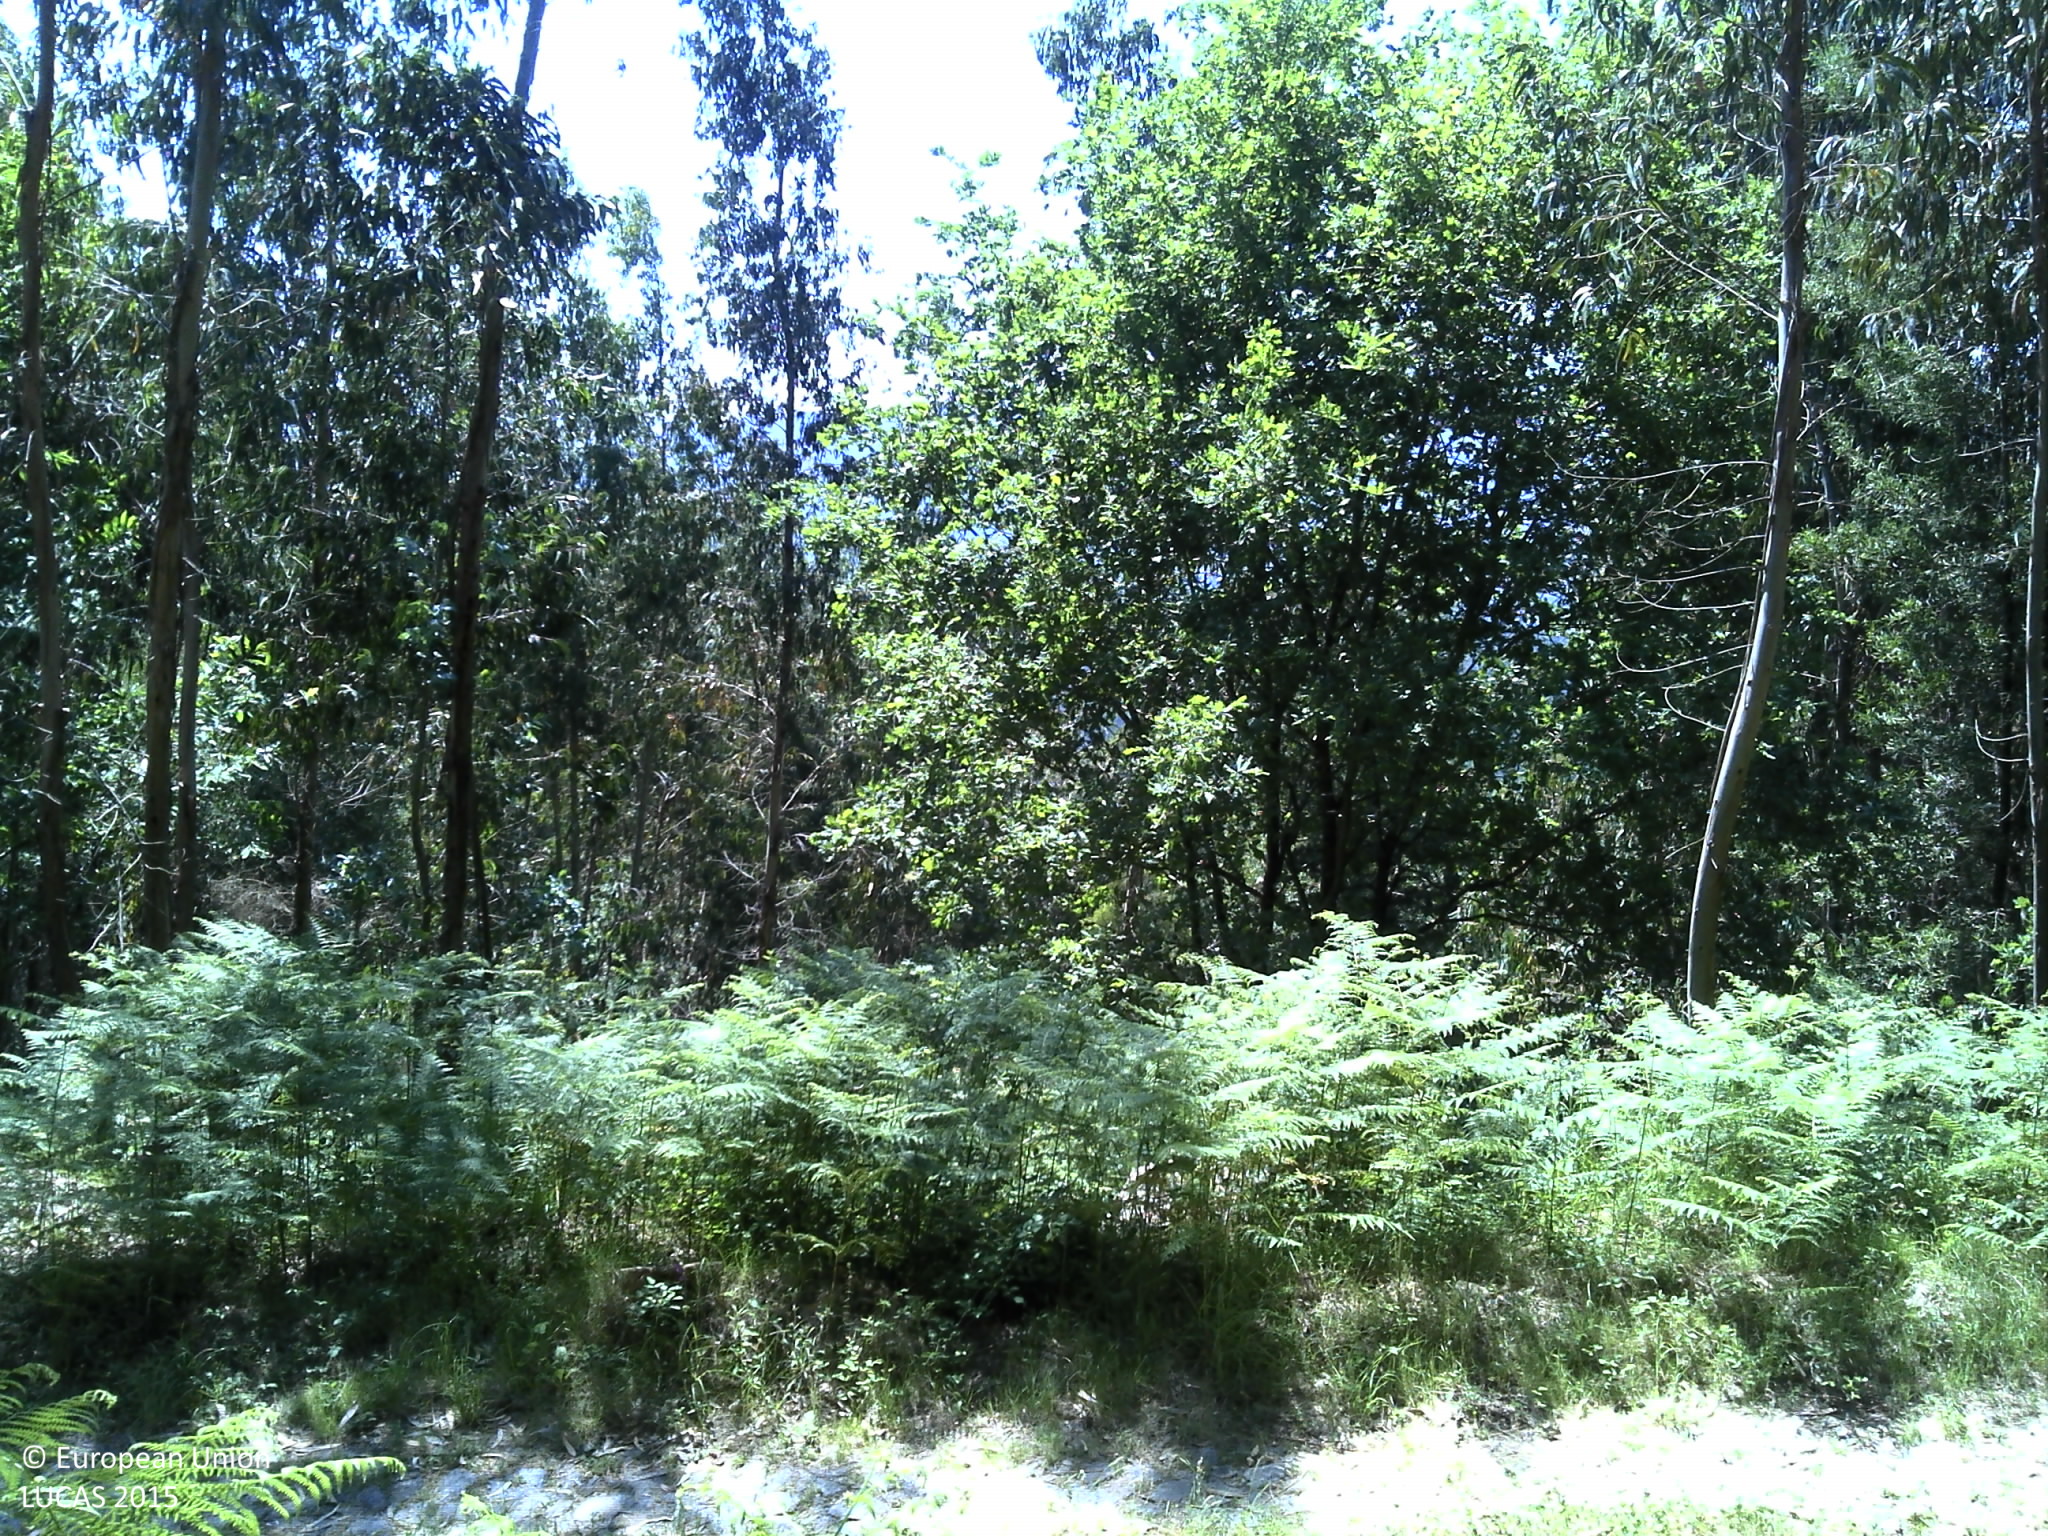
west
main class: Woodland
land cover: Broadleaved woodland
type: exotic forest
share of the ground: 50 - 75 %
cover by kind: broadleaved forest trees 50 %, shrubs 25 %, unconsolidated bare surface 25 %
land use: Forestry
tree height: > 5 m
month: May
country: PT
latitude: 41.7805
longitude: -8.6074
